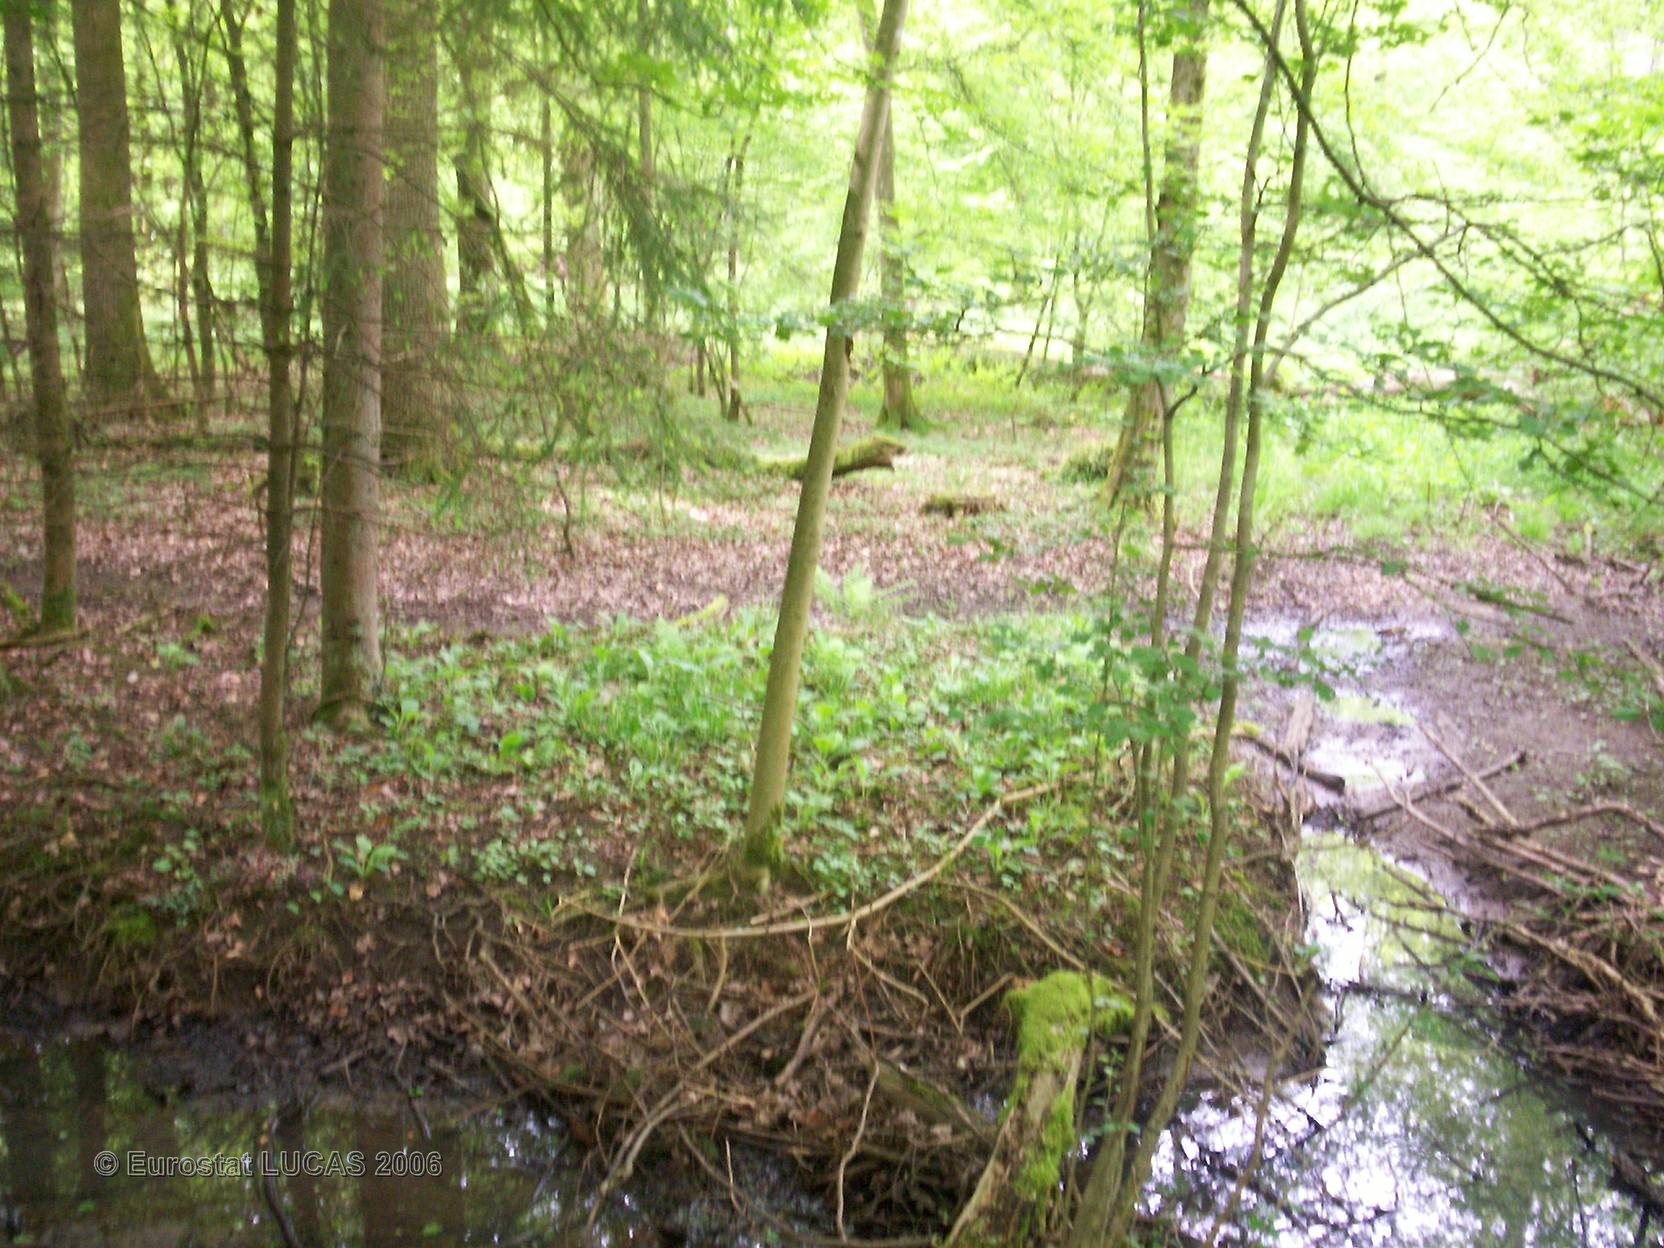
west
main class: Woodland
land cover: Mixed forest
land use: Forestry
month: May
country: FR
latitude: 49.3904
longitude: 6.4316
